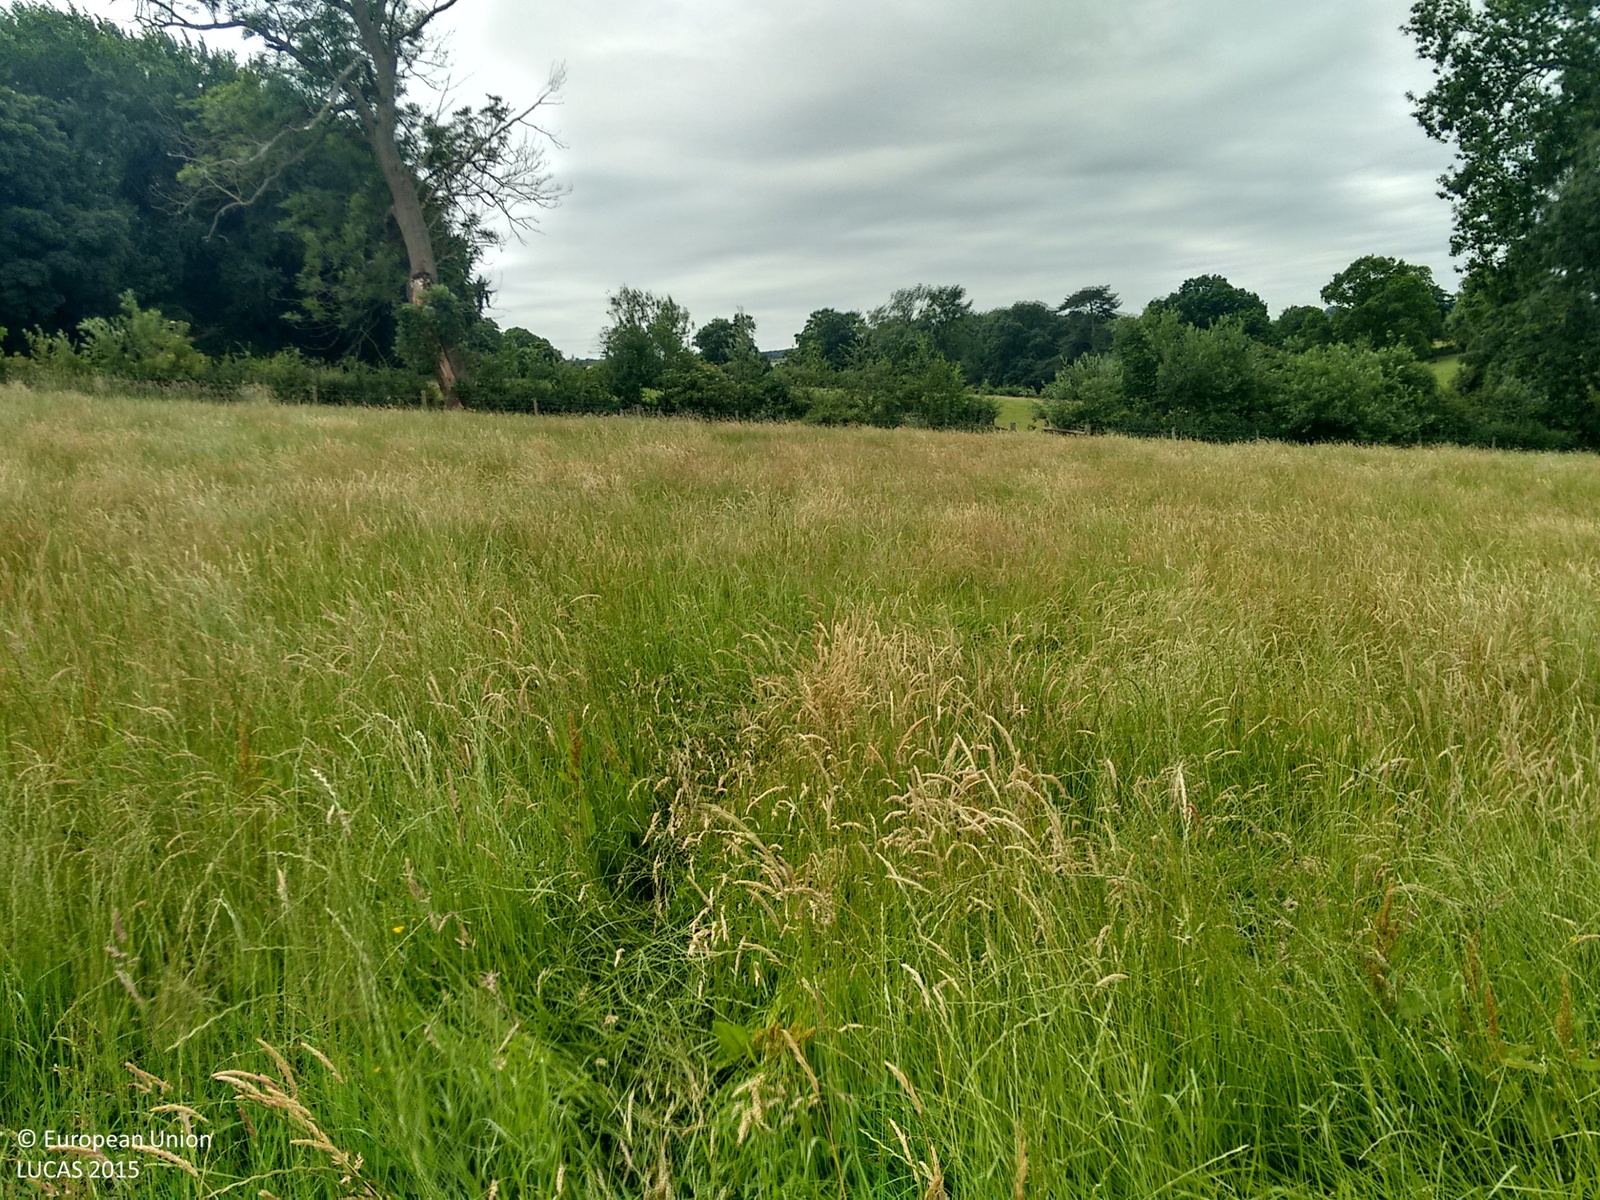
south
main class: Grassland
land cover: Grassland without tree/shrub cover
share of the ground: > 75 %
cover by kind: herbaceous plants 100 %
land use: Agriculture (excluding fallow land and kitchen gardens)
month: July
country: GB
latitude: 52.9554
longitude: -1.5577
